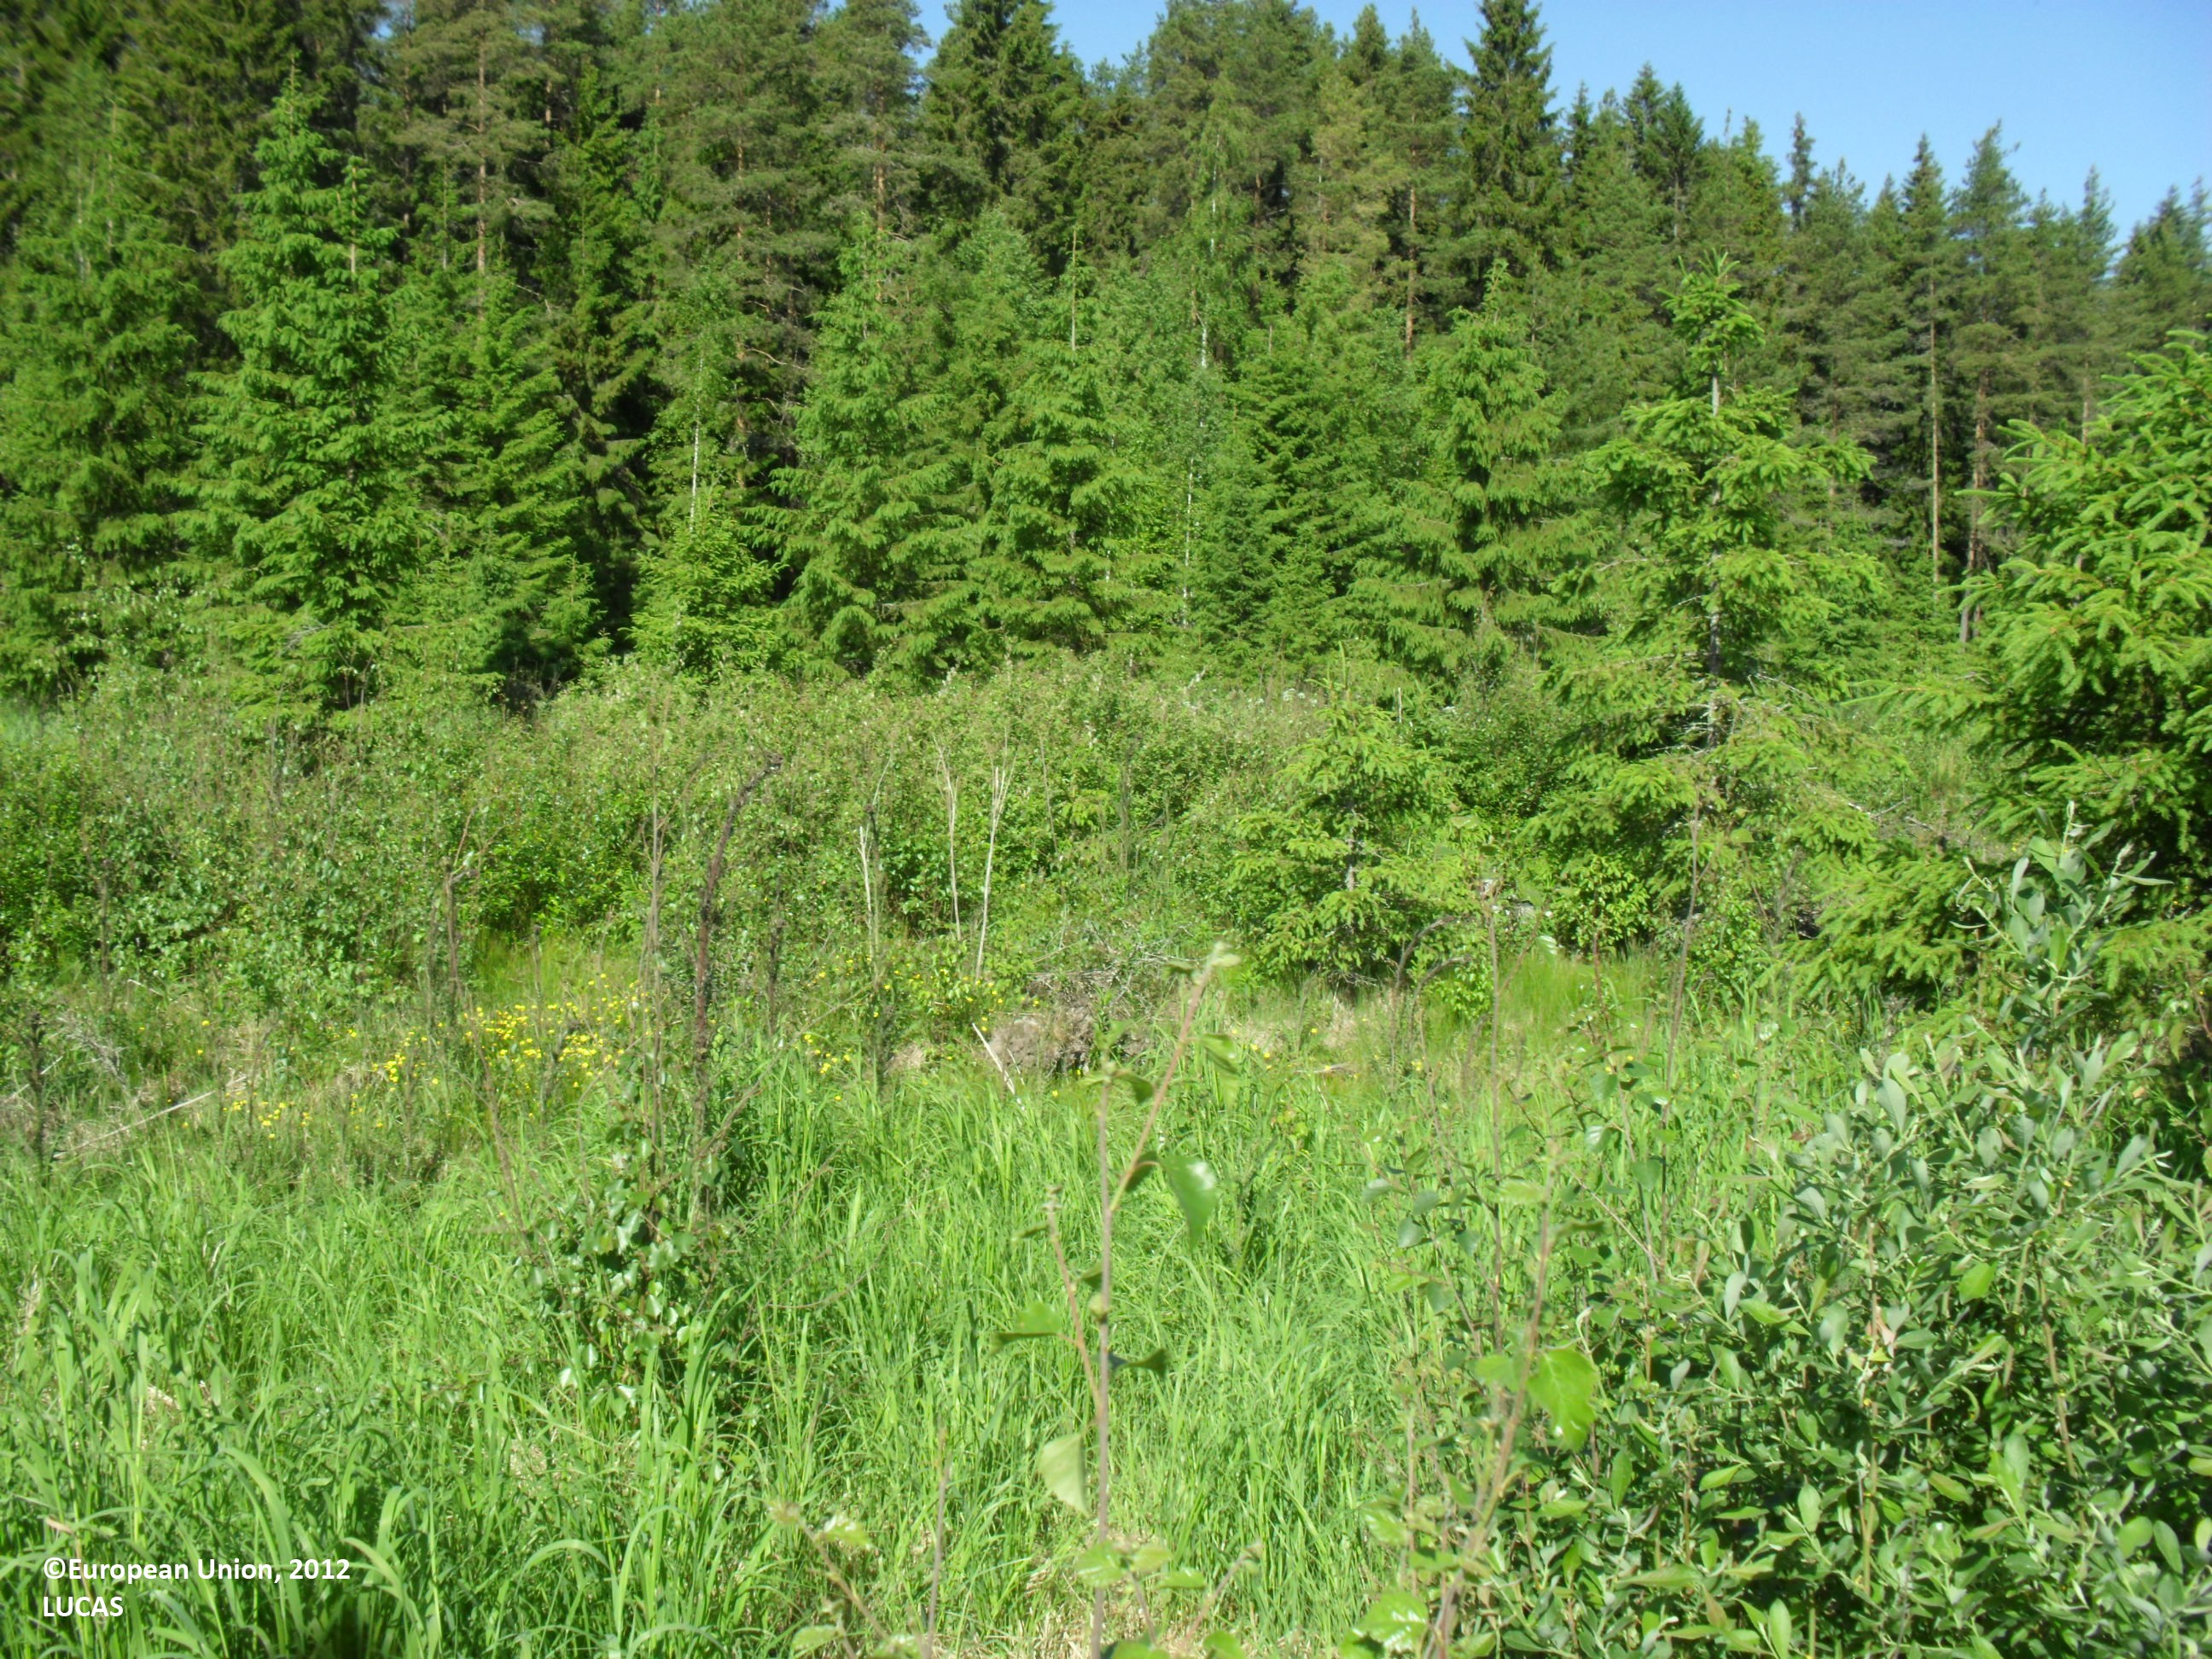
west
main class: Woodland
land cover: Other mixed woodland
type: boreal forest
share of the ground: 10 - 25 %
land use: Forestry
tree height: < 5 m
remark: Clear cut
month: June
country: FI
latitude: 62.9542
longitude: 23.0907
